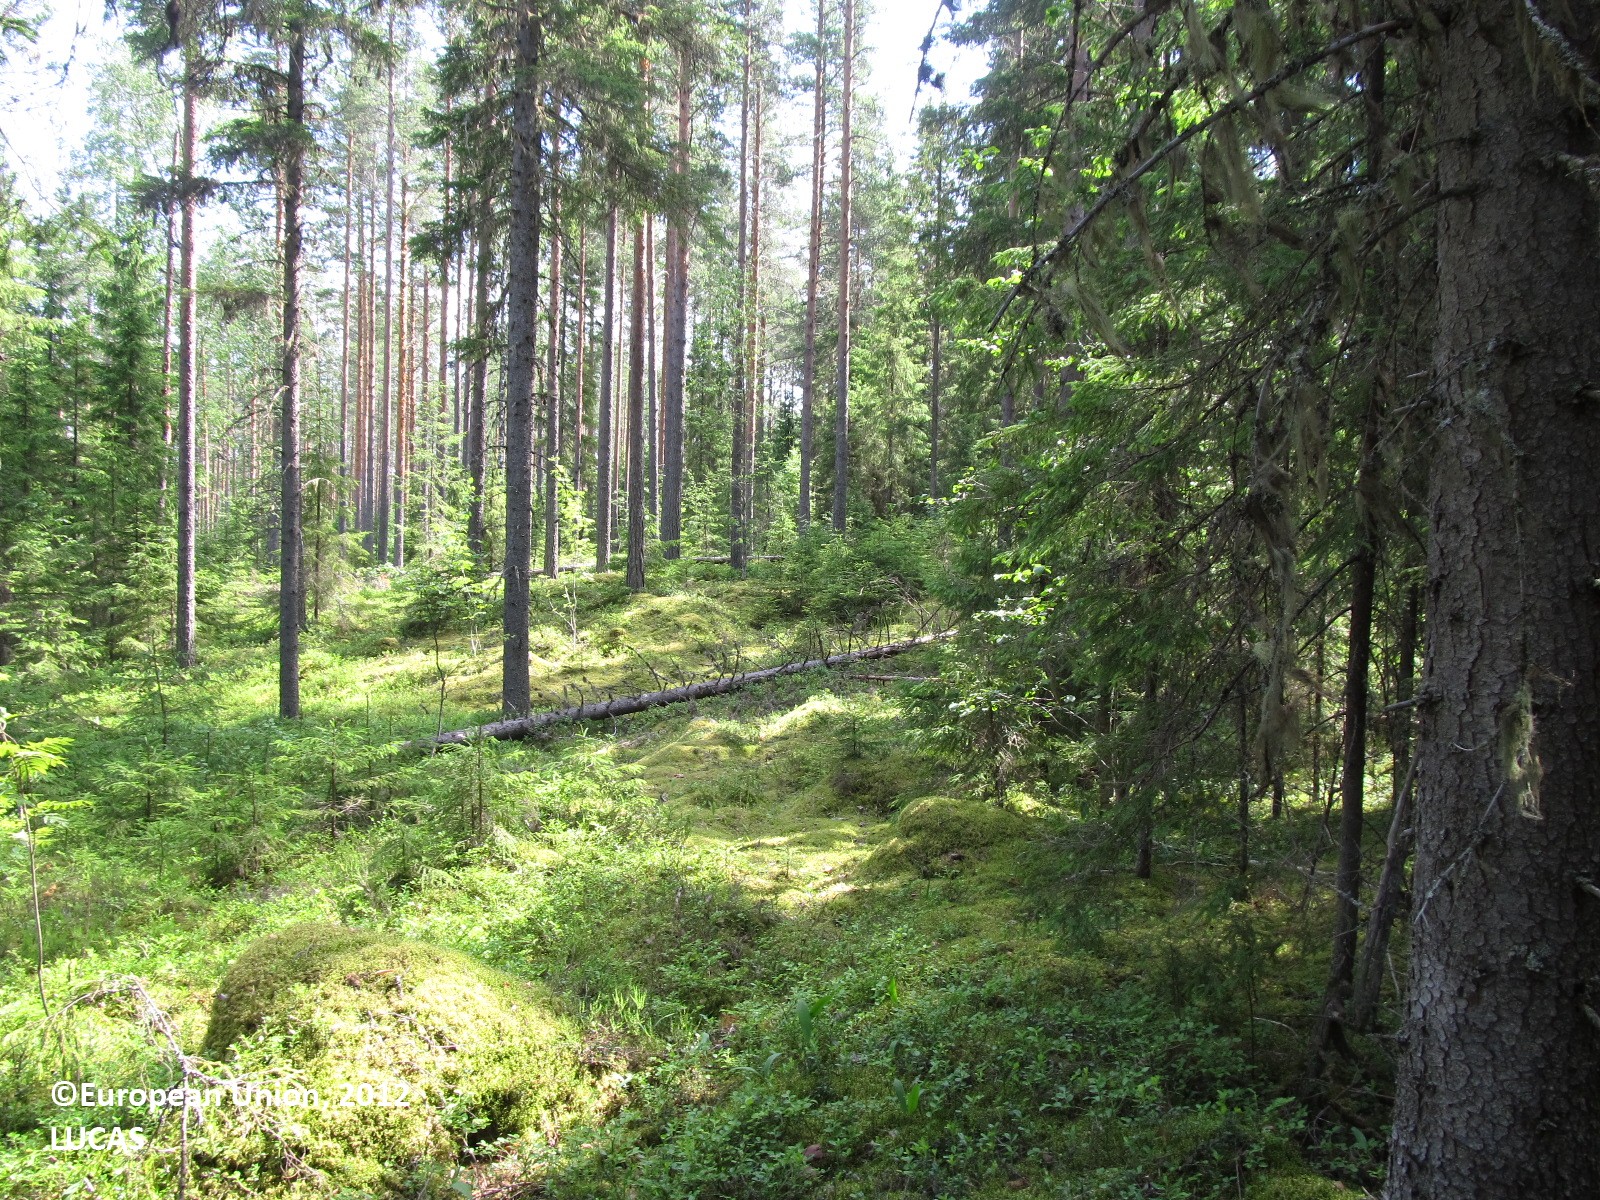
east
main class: Woodland
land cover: Spruce dominated coniferous woodland
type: boreal forest
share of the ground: 25 - 50 %
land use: Forestry
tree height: > 5 m
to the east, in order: Spruce dominated coniferous woodland; Pine dominated coniferous woodland; Grassland with sparse tree/shrub cover; Pine dominated coniferous woodland; Paved roads, cycling and walking lanes
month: July
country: FI
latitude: 62.0023
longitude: 29.1150
